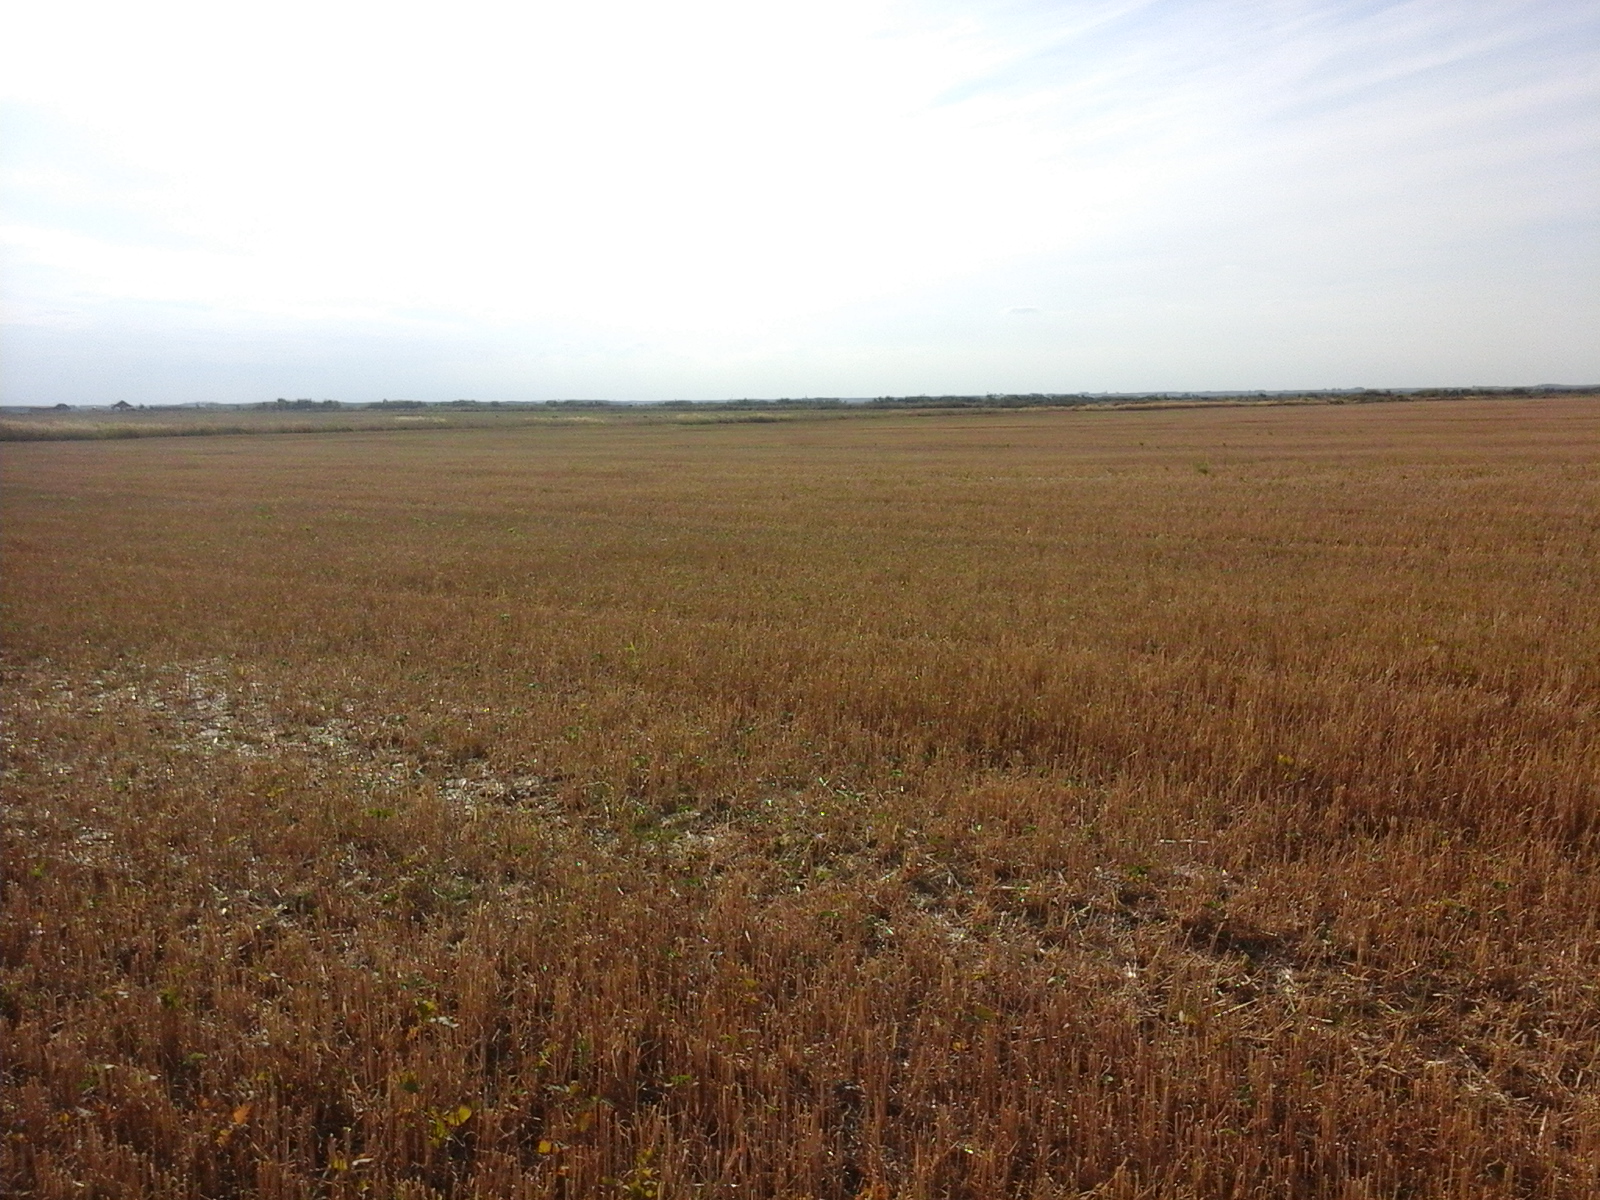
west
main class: Cropland
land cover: Common wheat
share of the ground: > 75 %
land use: Agriculture (excluding fallow land and kitchen gardens)
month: August
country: RO
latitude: 45.2327
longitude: 21.3784
